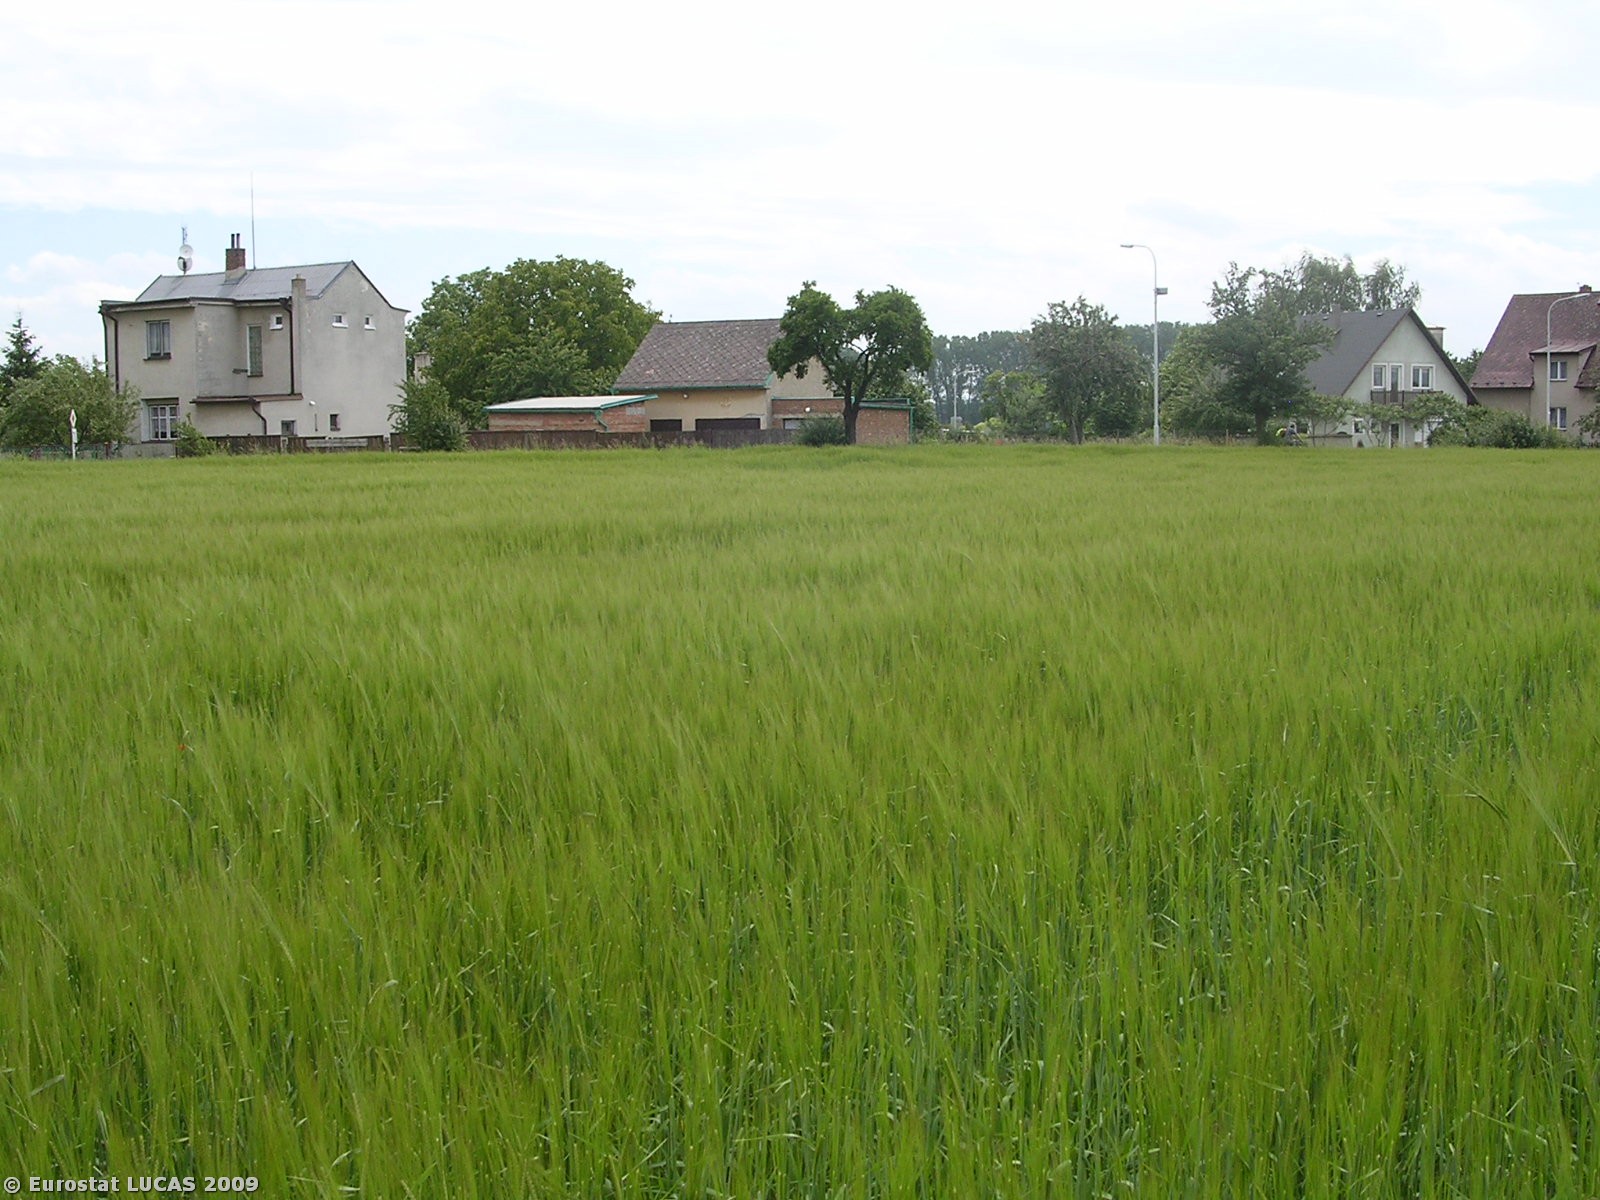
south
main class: Cropland
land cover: Barley
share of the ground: > 75 %
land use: Agriculture (excluding fallow land and kitchen gardens)
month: June
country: CZ
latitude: 50.4875
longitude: 15.0347
